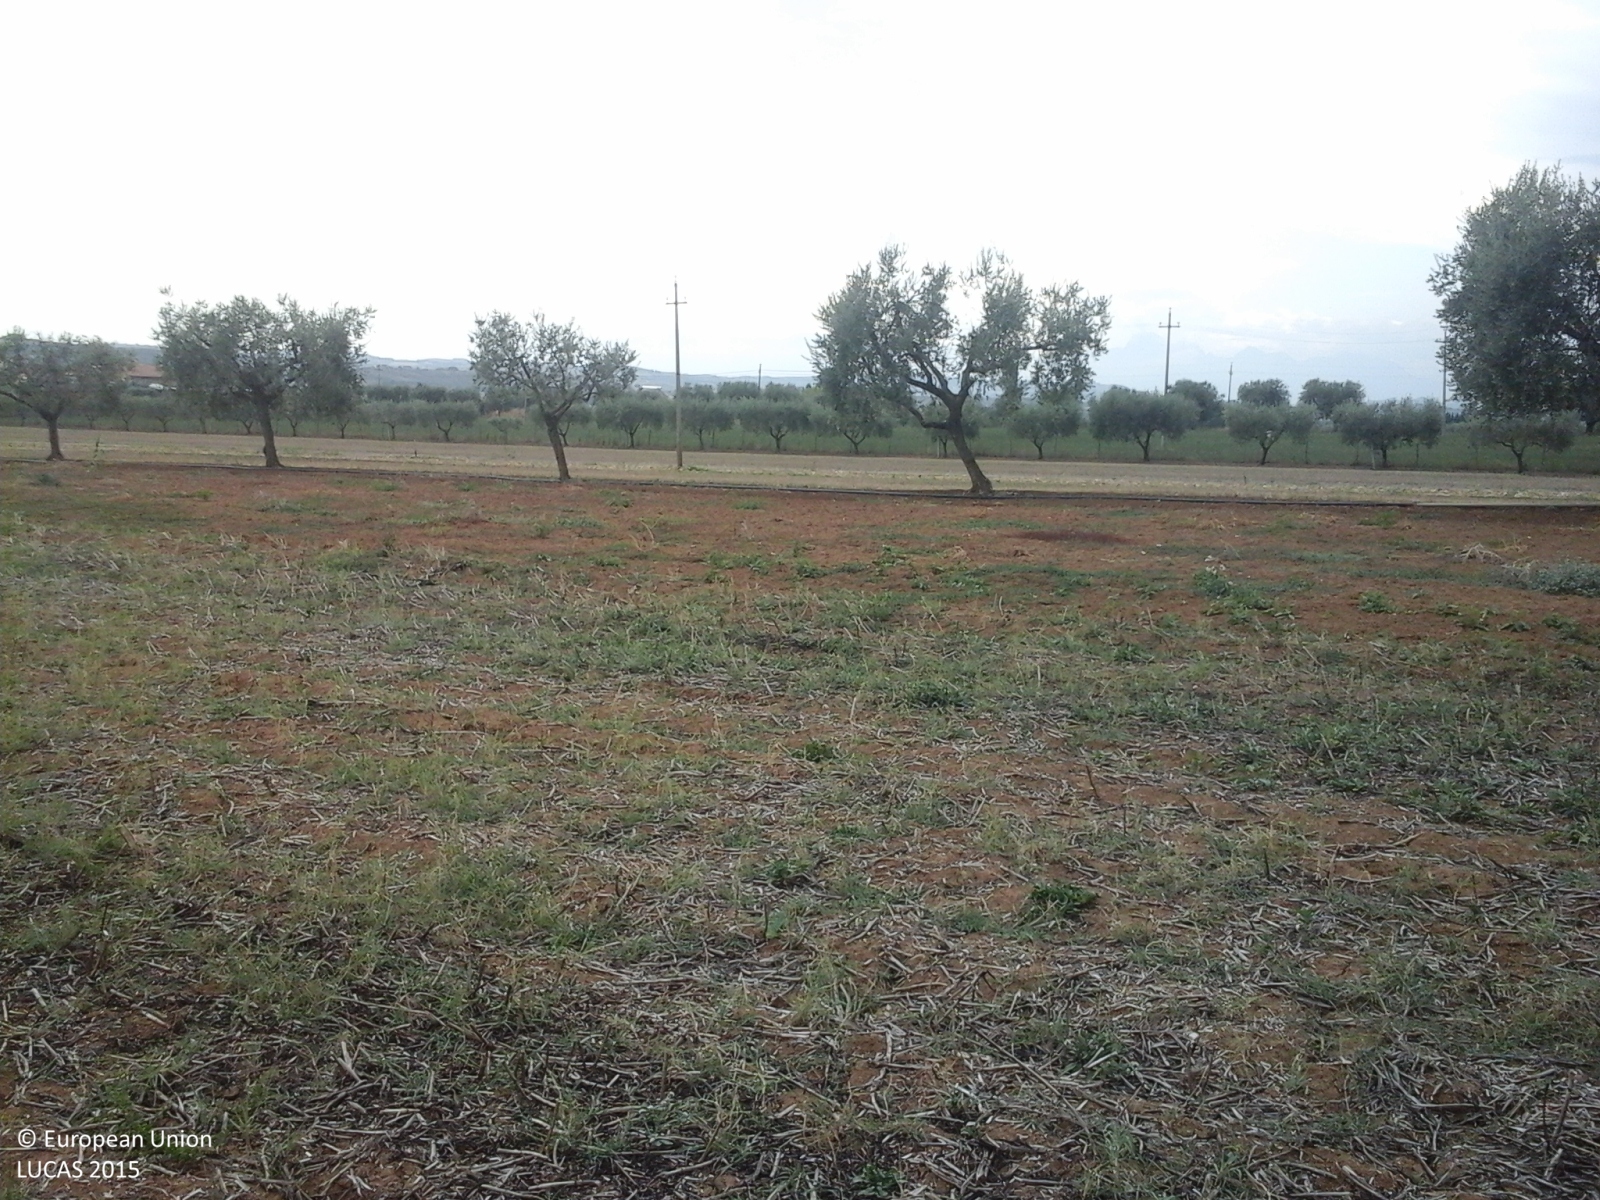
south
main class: Cropland
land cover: Dry pulses
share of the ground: > 75 %
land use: Agriculture (excluding fallow land and kitchen gardens)
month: September
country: IT
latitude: 42.8333
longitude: 13.8674
